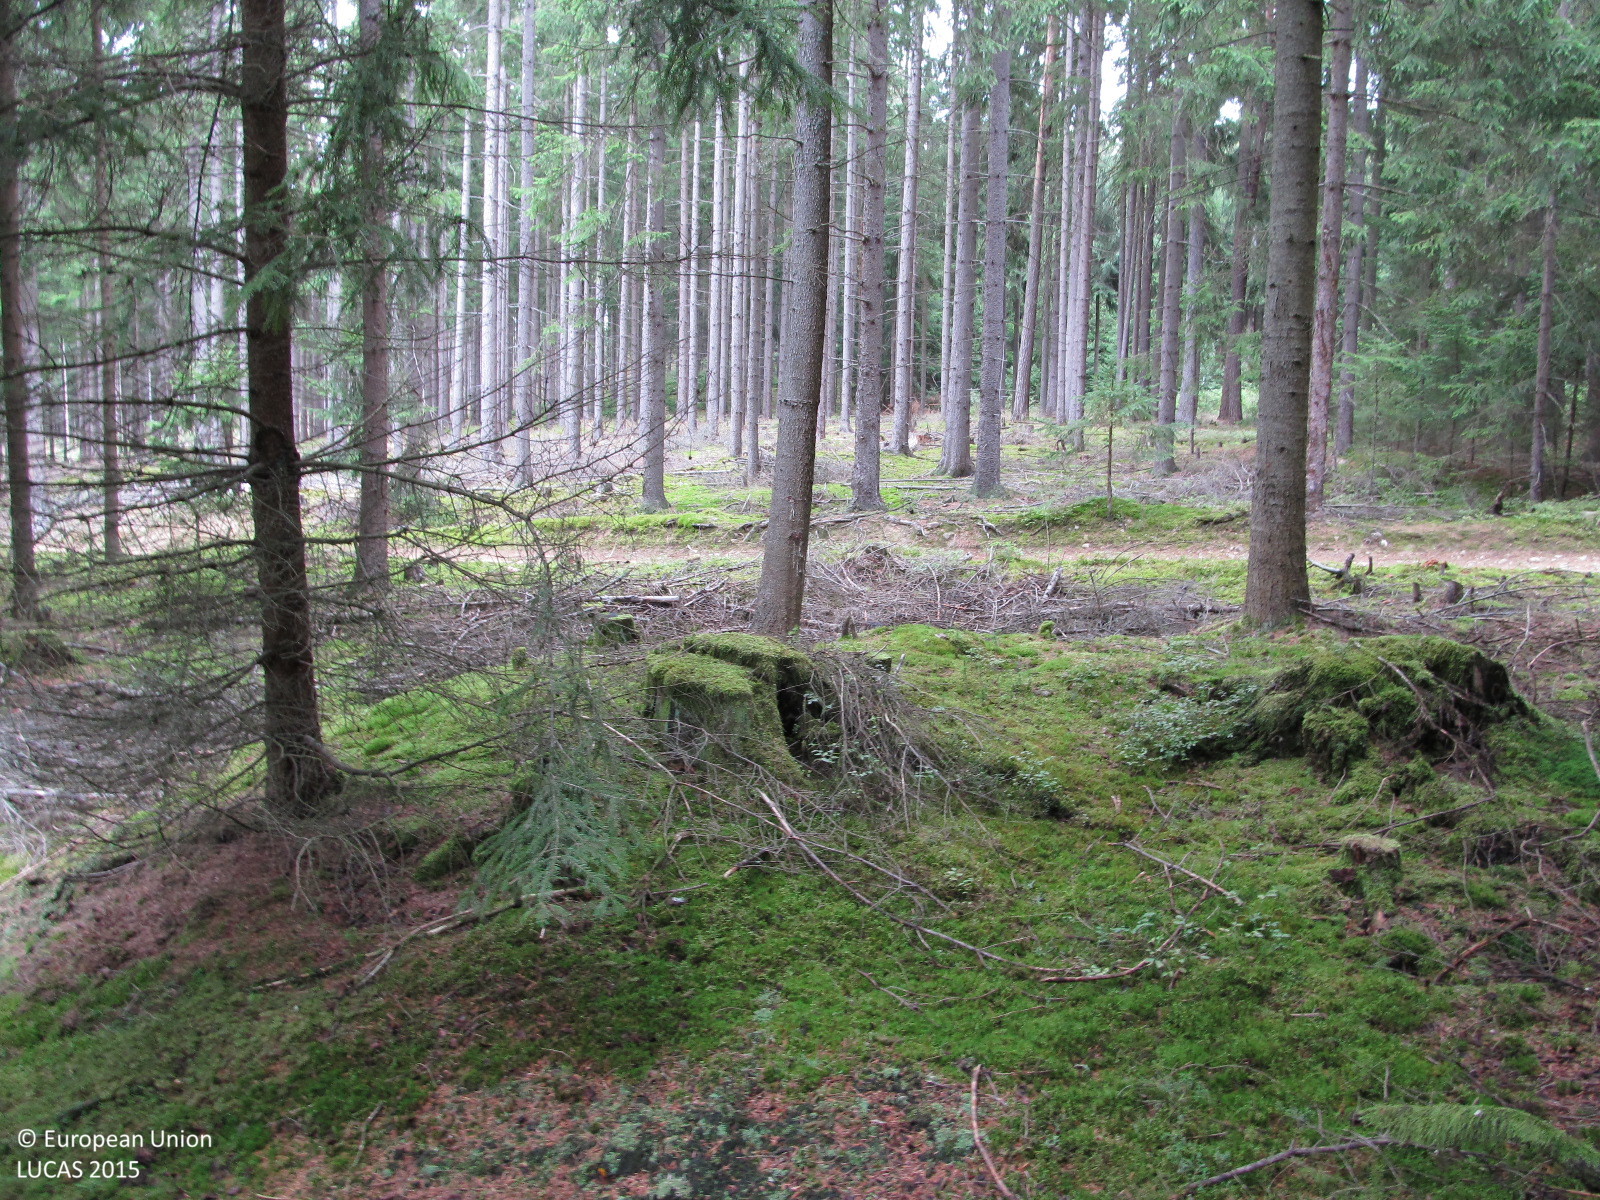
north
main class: Woodland
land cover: Spruce dominated coniferous woodland
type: hemiboreal forest and nemoral coniferous forest and mixed broadleaved-coniferous forest
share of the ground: > 75 %
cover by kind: coniferous forest trees 80 %, herbaceous plants 10 %, lichens and mosses 10 %
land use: Forestry
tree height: > 5 m
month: September
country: AT
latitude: 48.9761
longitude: 15.3723
